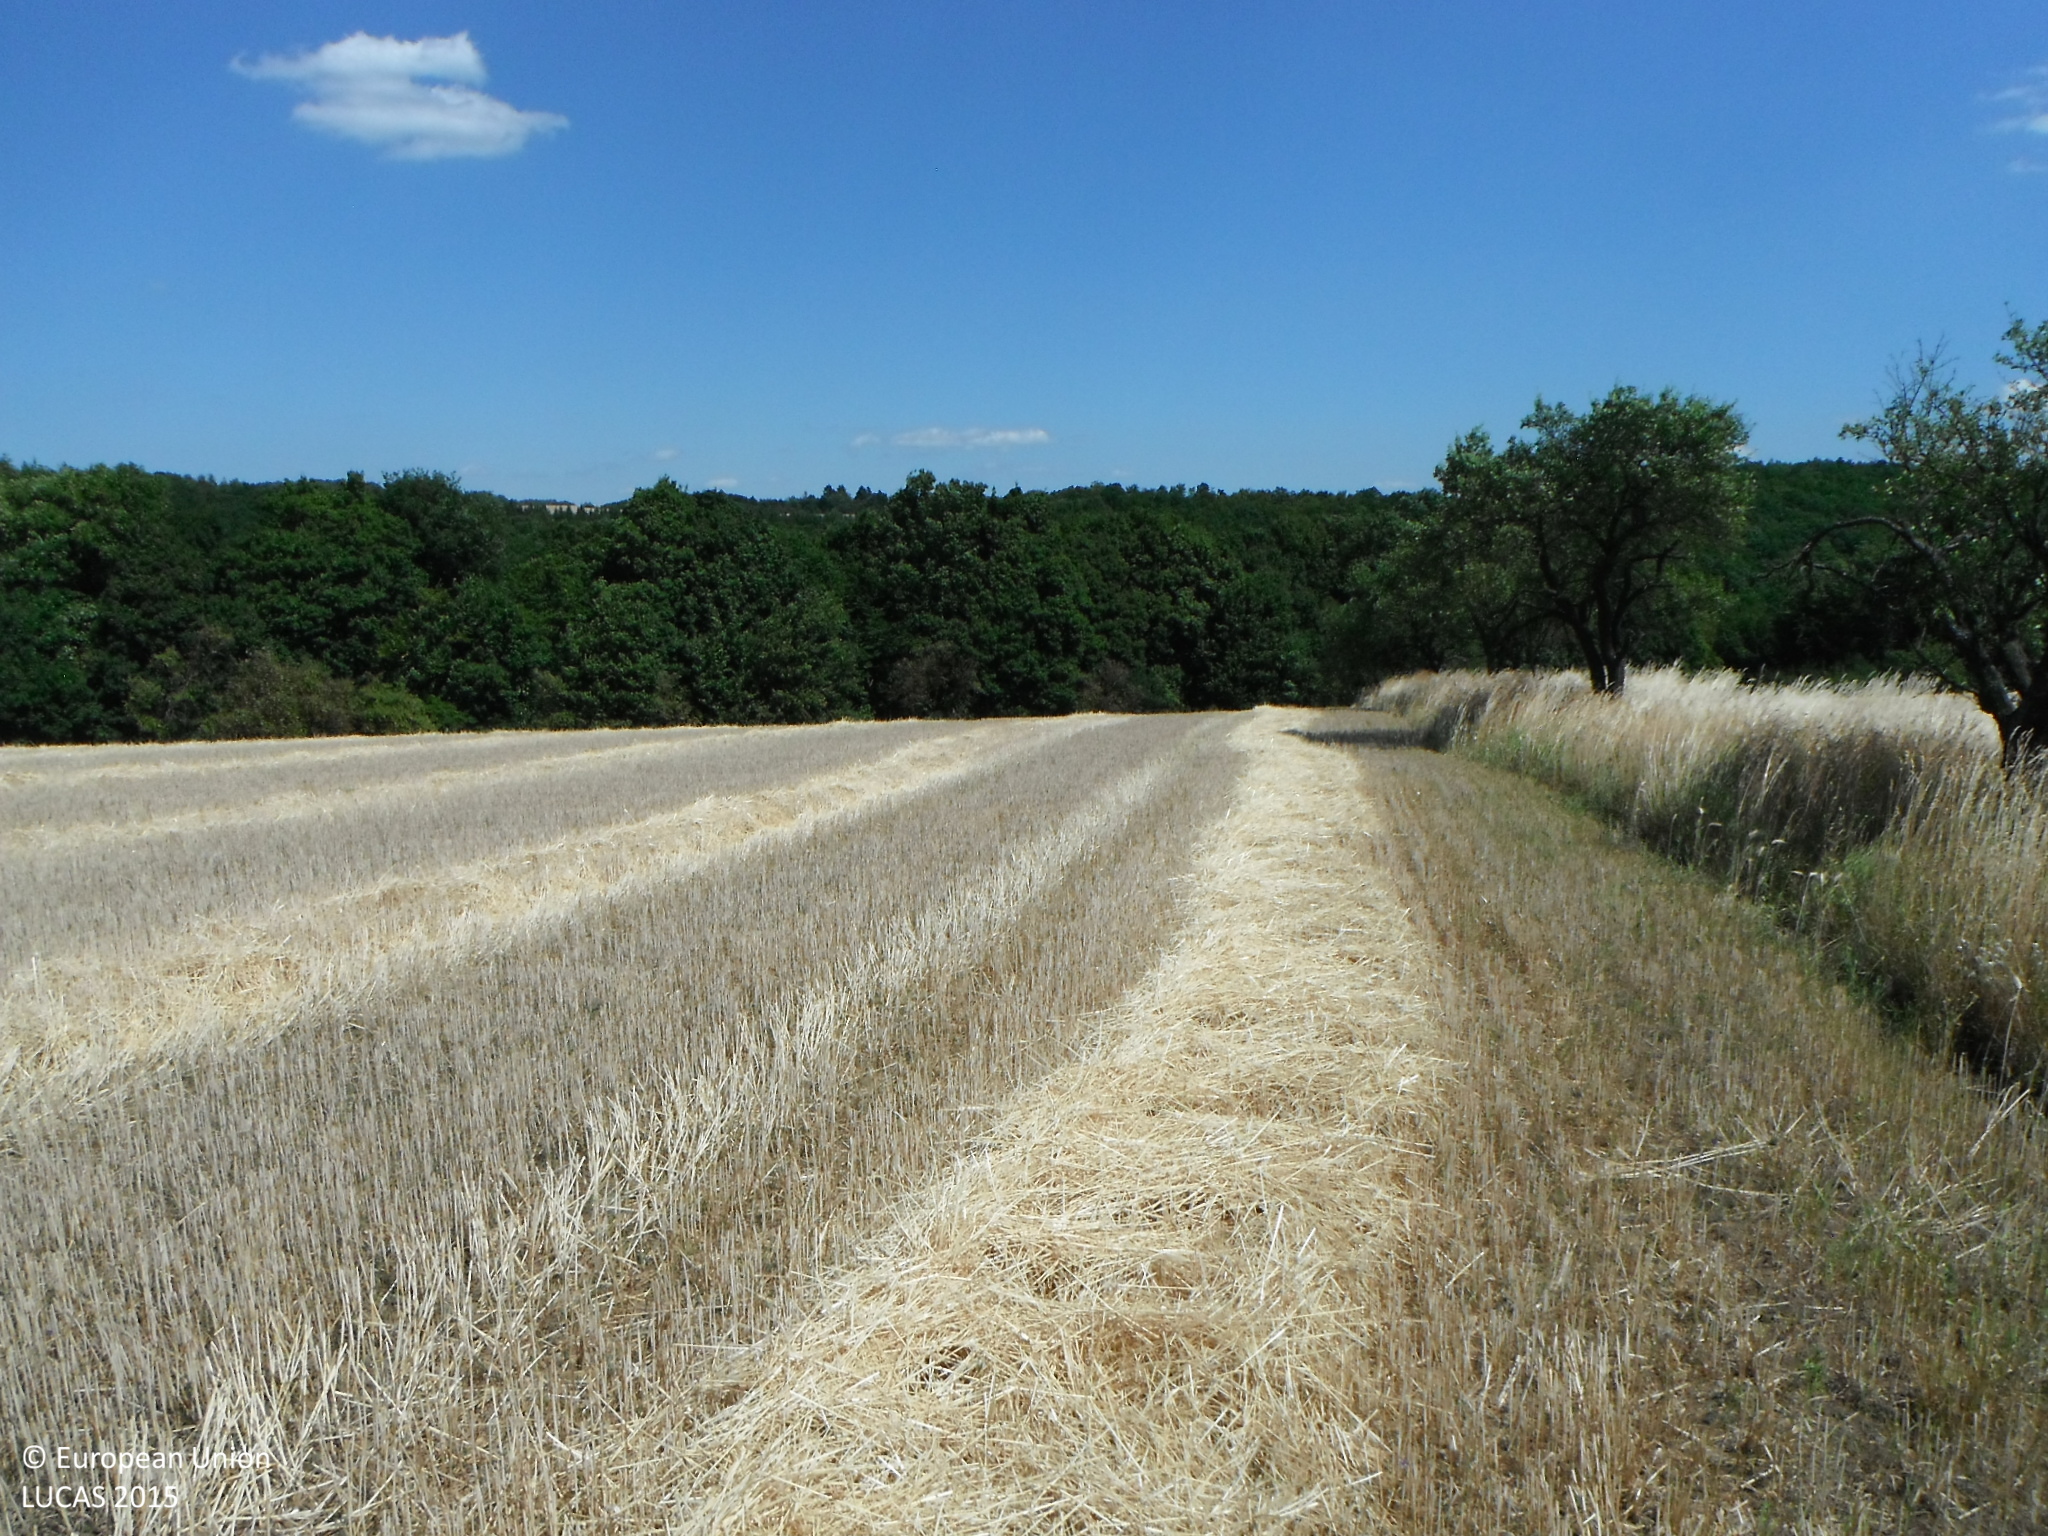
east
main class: Cropland
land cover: Common wheat
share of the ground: > 75 %
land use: Agriculture (excluding fallow land and kitchen gardens)
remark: Harvested field
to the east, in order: Common wheat; Broadleaved woodland; Ditches and canals; Paved roads, cycling and walking lanes; Broadleaved woodland; Spontaneously vegetated surfaces
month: July
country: SK
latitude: 48.3109
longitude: 19.1769
